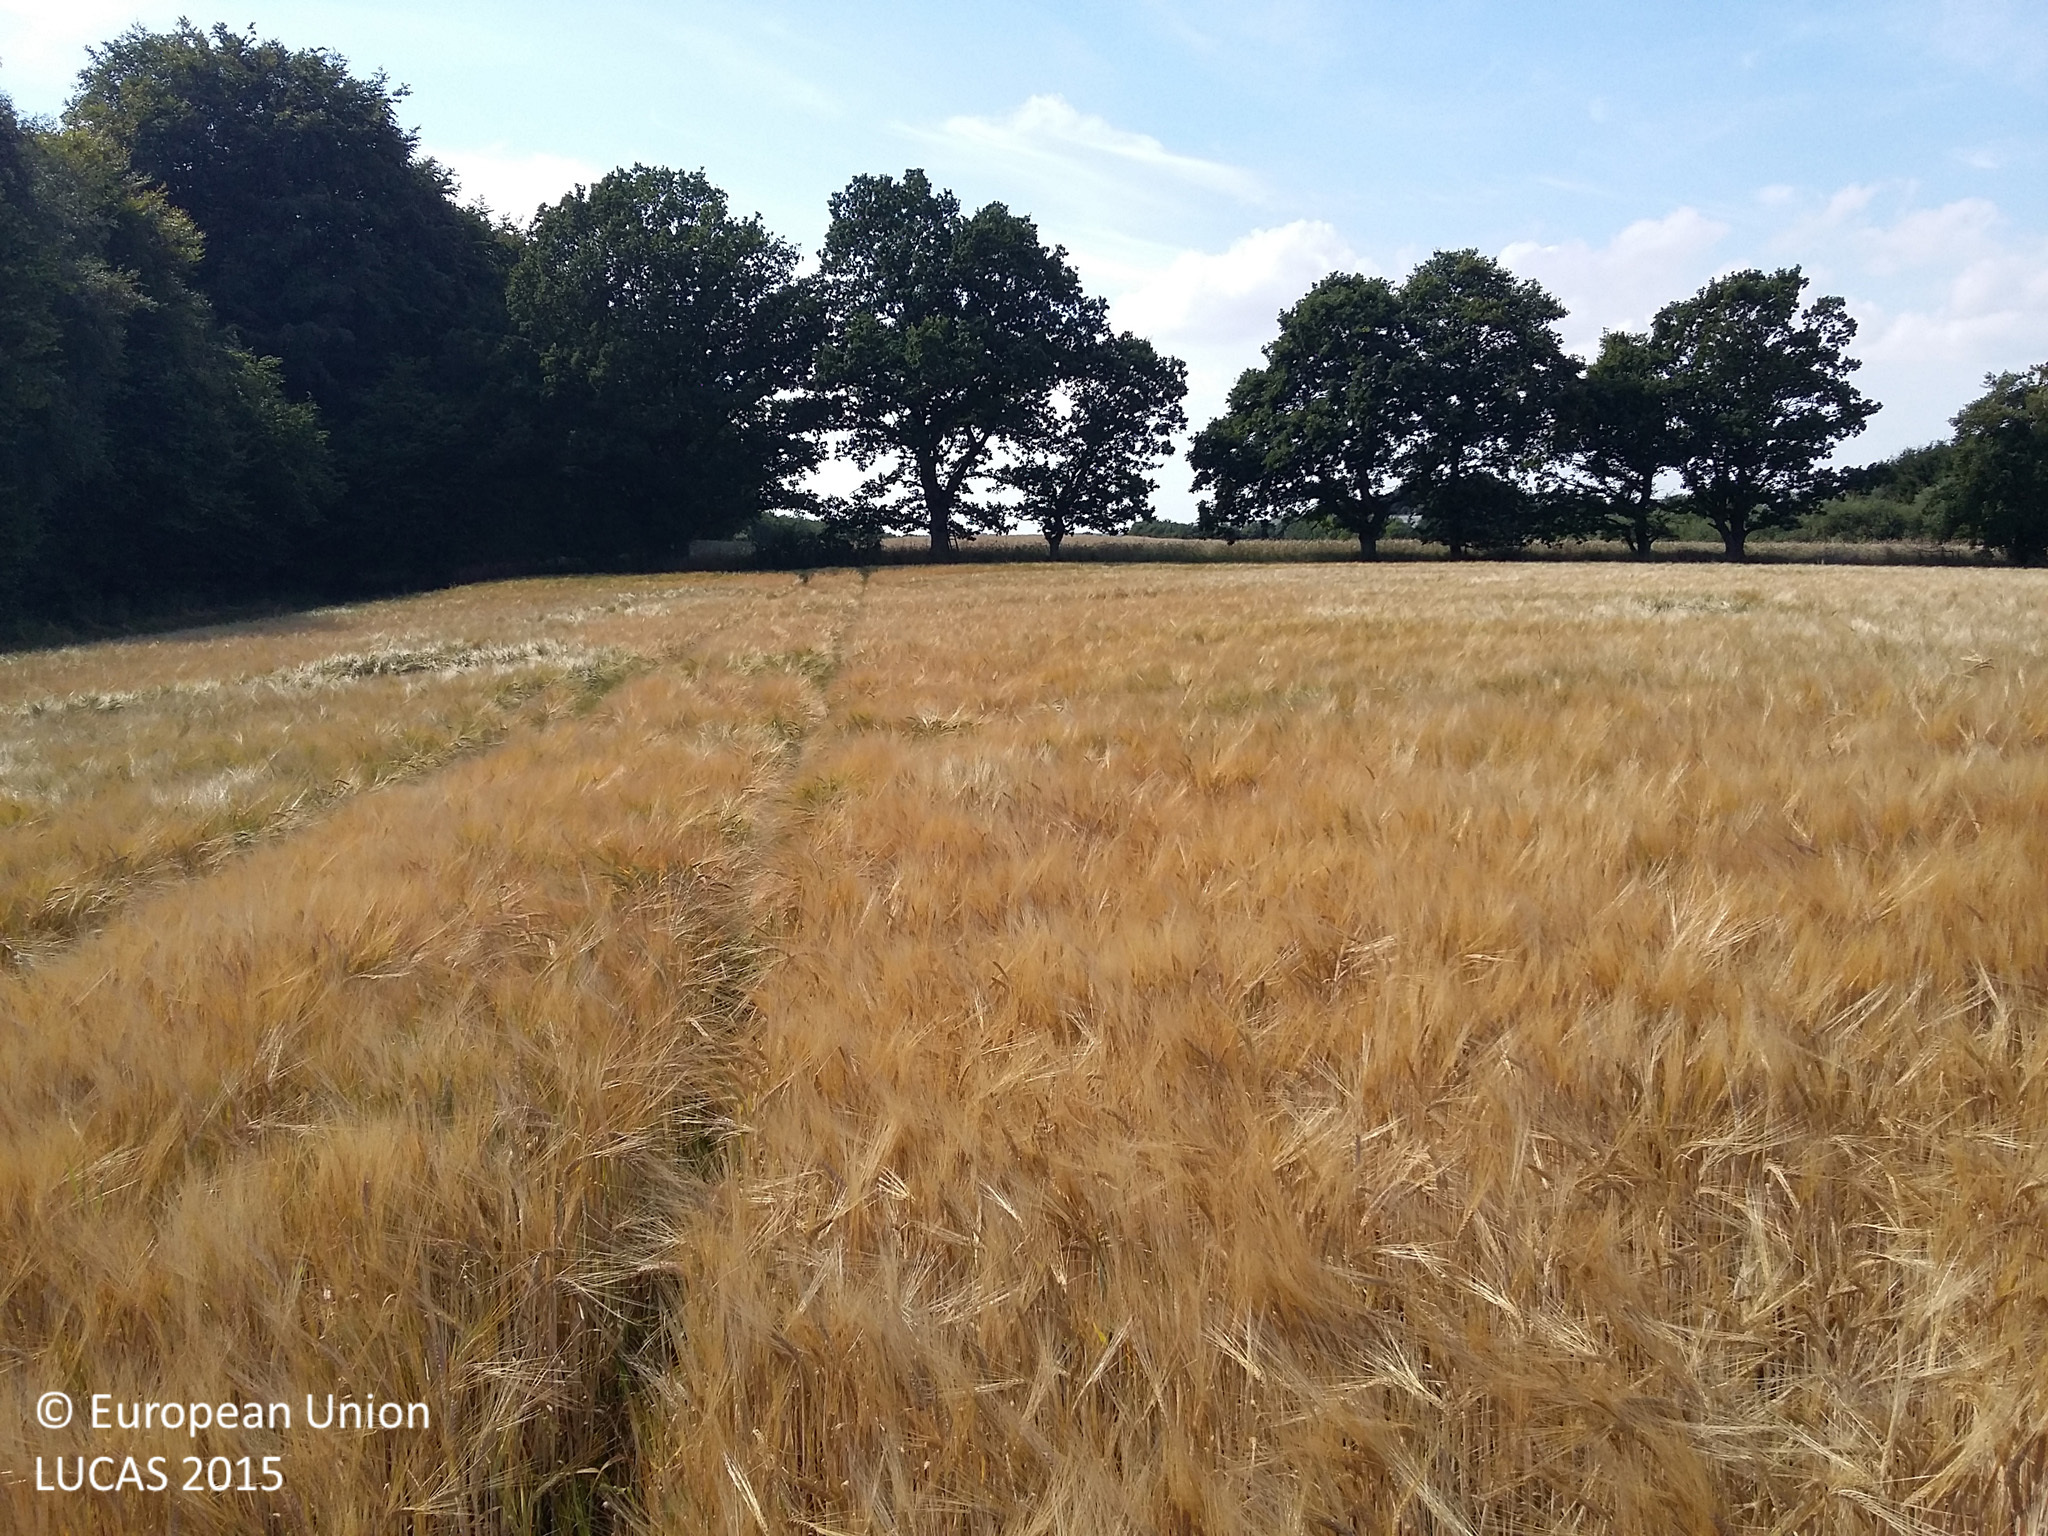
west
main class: Cropland
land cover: Barley
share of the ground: > 75 %
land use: Agriculture (excluding fallow land and kitchen gardens)
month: August
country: DK
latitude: 55.3484
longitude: 11.7806
